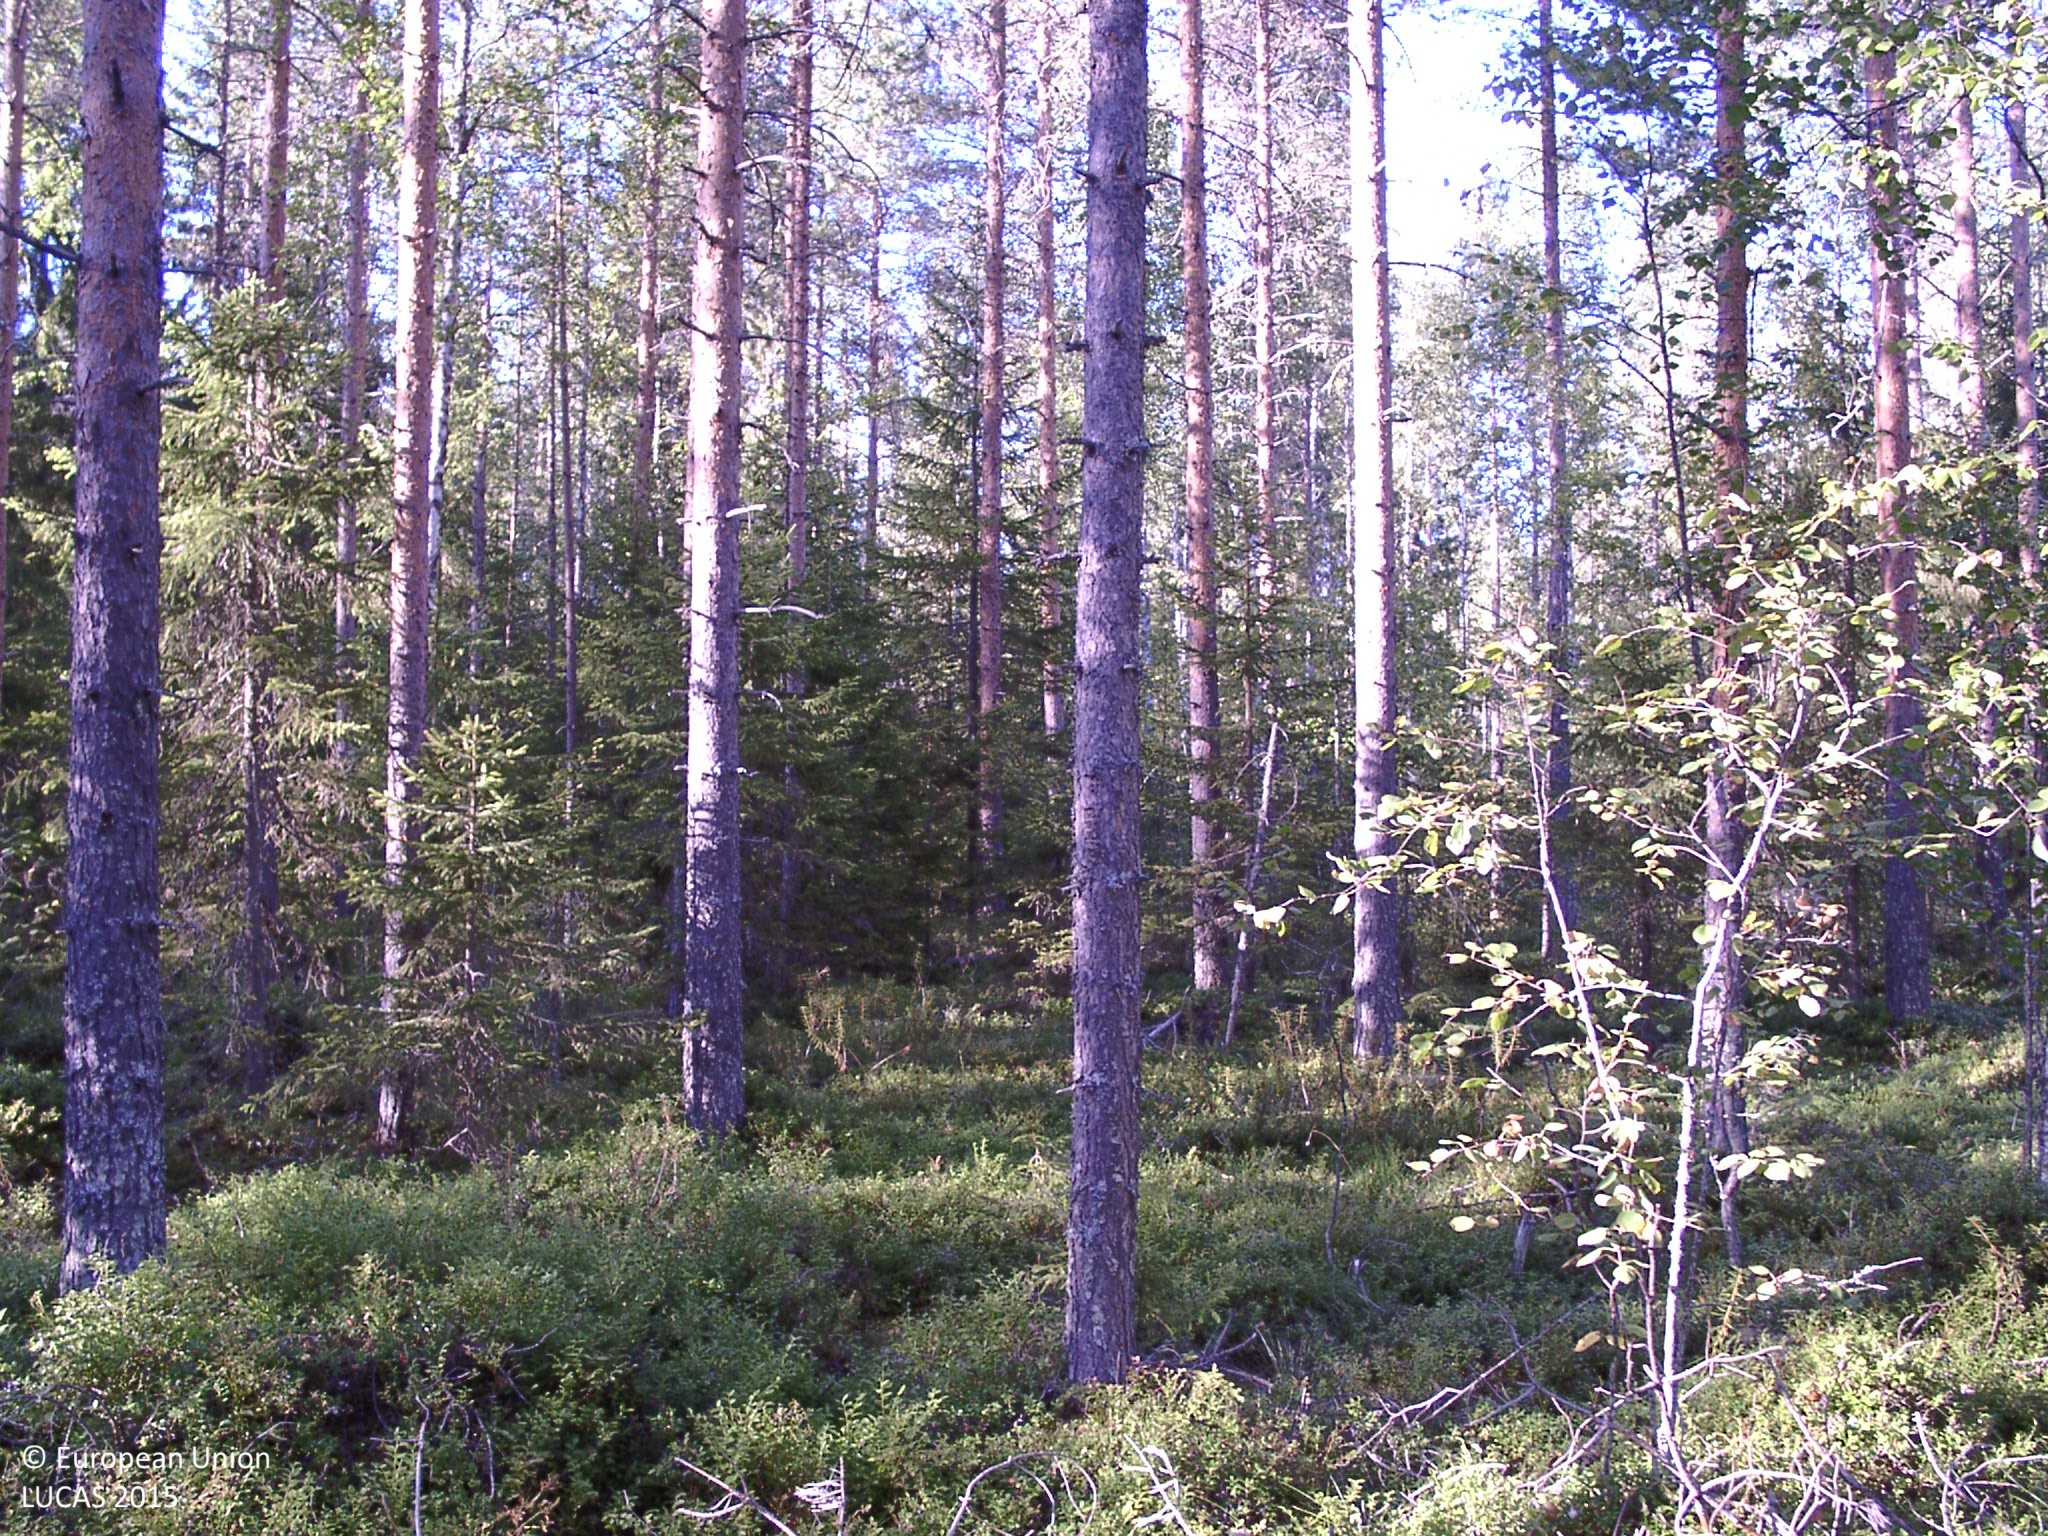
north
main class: Woodland
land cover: Other mixed woodland
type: boreal forest
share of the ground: 50 - 75 %
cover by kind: coniferous forest trees 50 %, shrubs 25 %, broadleaved forest trees 20 %, lichens and mosses 5 %
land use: Forestry
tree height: > 5 m
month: August
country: FI
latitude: 62.4286
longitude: 25.1520
